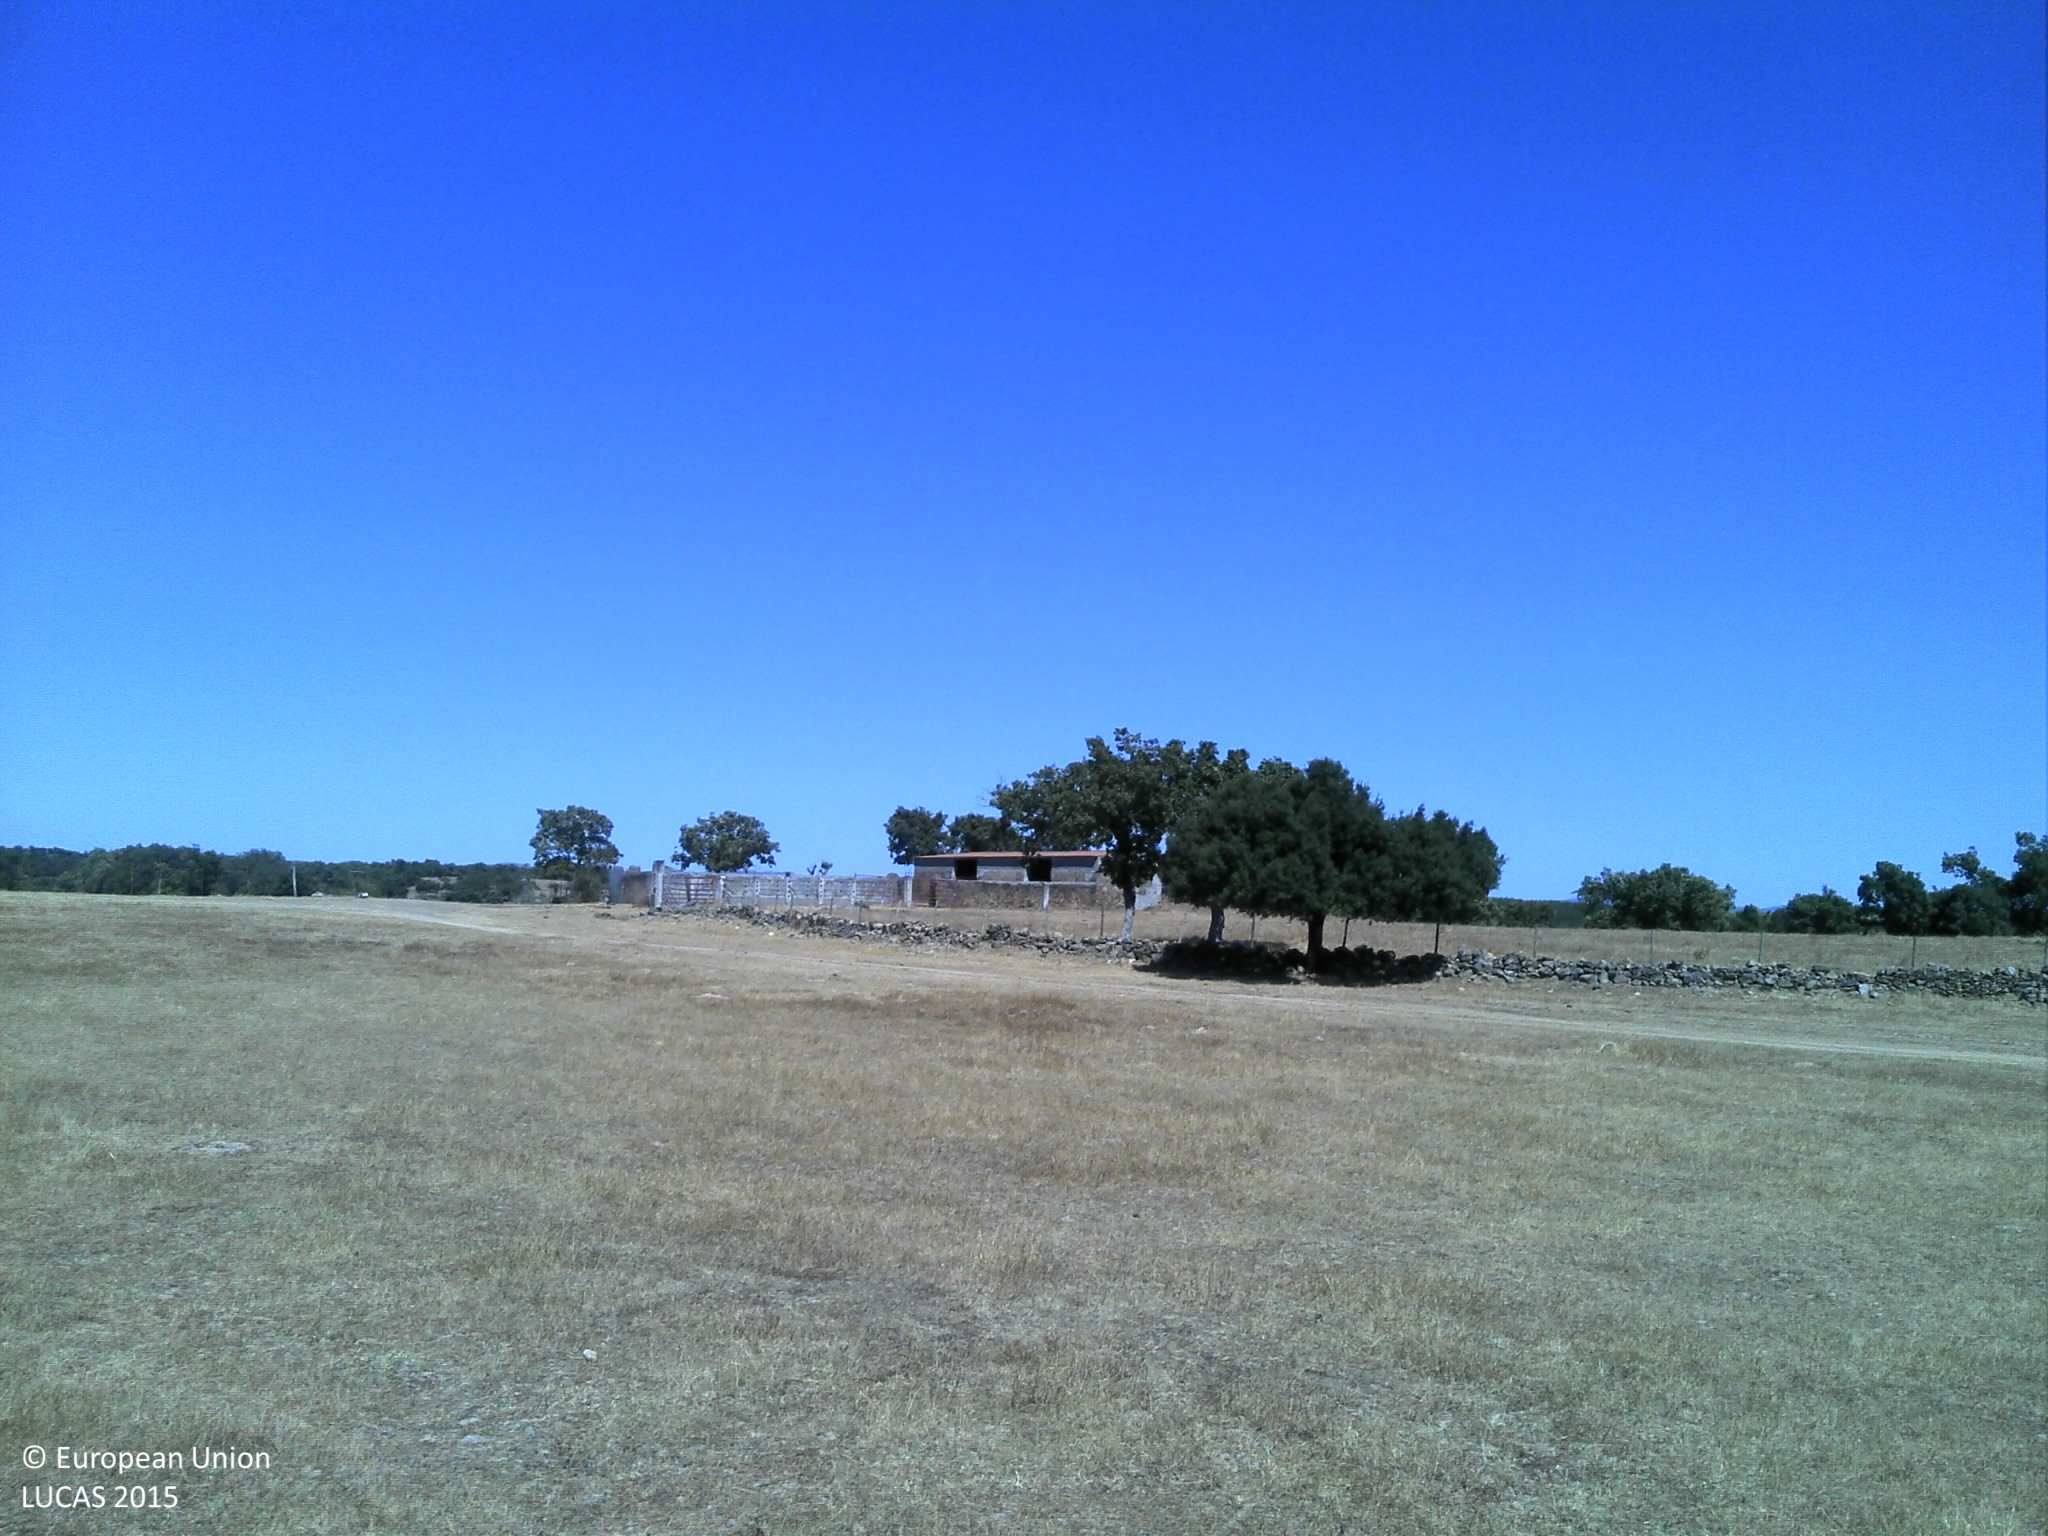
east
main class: Grassland
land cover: Grassland without tree/shrub cover
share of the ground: 10 - 25 %
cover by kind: unconsolidated bare surface 90 %, herbaceous plants 10 %
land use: Agriculture (excluding fallow land and kitchen gardens)
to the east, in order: Grassland without tree/shrub cover; Other bare soil; Grassland without tree/shrub cover; Tracks; Grass margins; Single bushes/trees; Dry stone walls; Fences; Broadleaved woodland; Grassland without tree/shrub cover; Artificial constructions in urban areas; Grassland without tree/shrub cover; Broadleaved woodland; Dry stone walls; Fences; Tracks; Dry stone walls; Broadleaved woodland; Olive groves; Grassland without tree/shrub cover; Olive groves
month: July
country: PT
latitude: 39.3584
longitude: -7.6296
